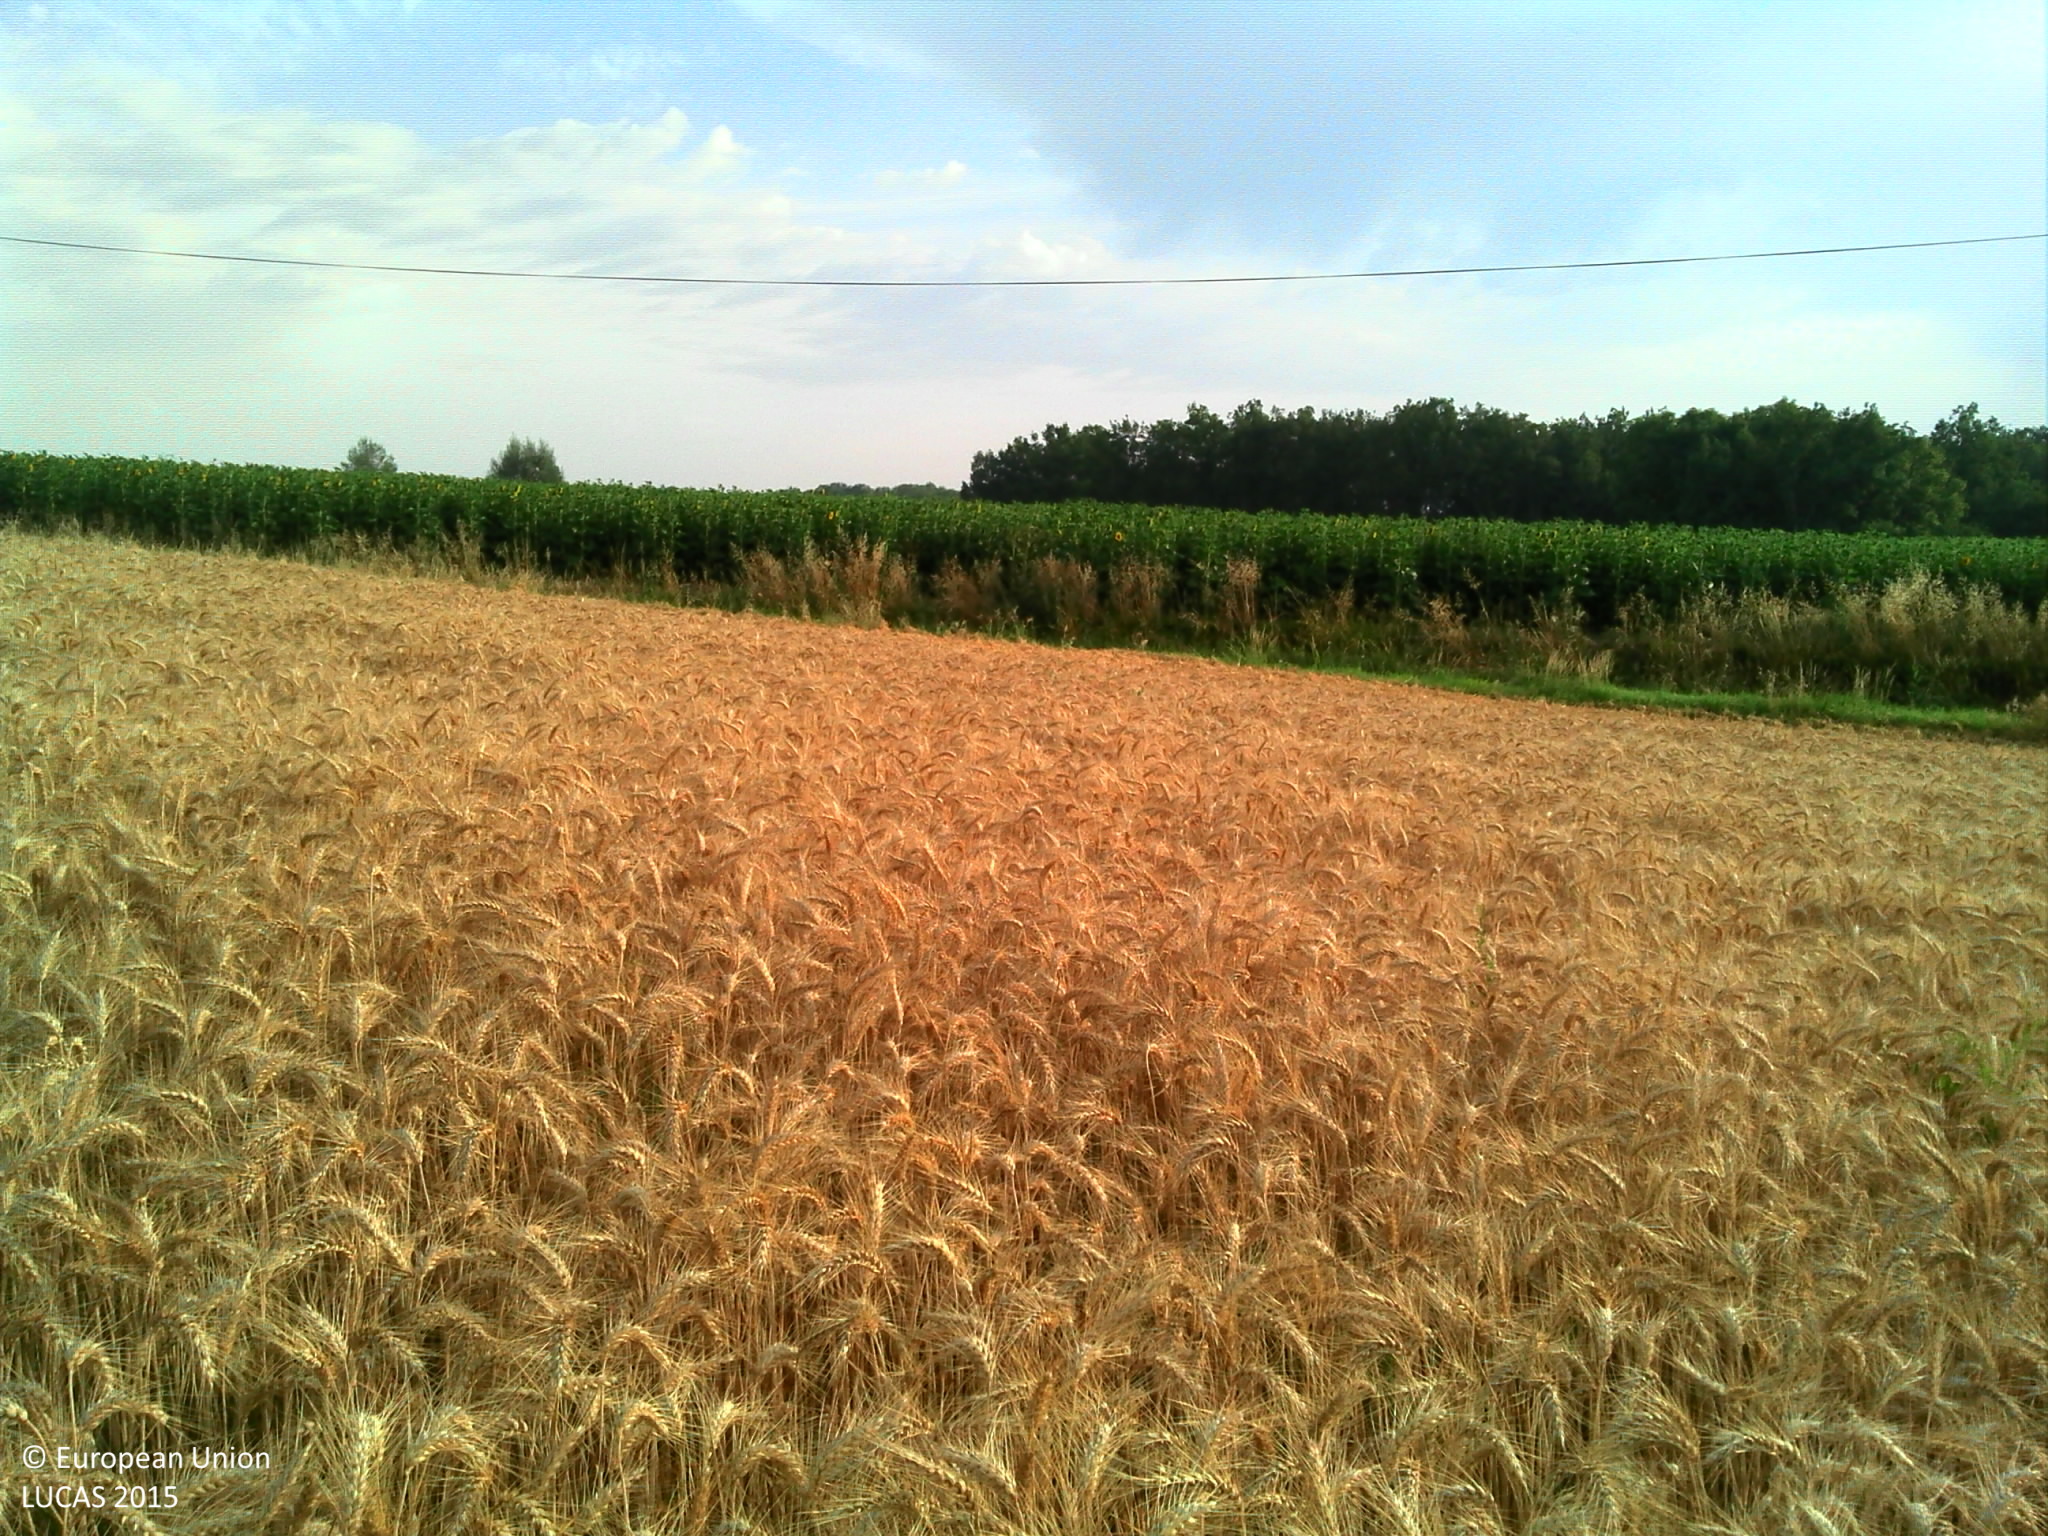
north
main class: Cropland
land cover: Common wheat
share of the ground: > 75 %
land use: Agriculture (excluding fallow land and kitchen gardens)
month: July
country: FR
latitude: 44.5035
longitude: 0.7999
